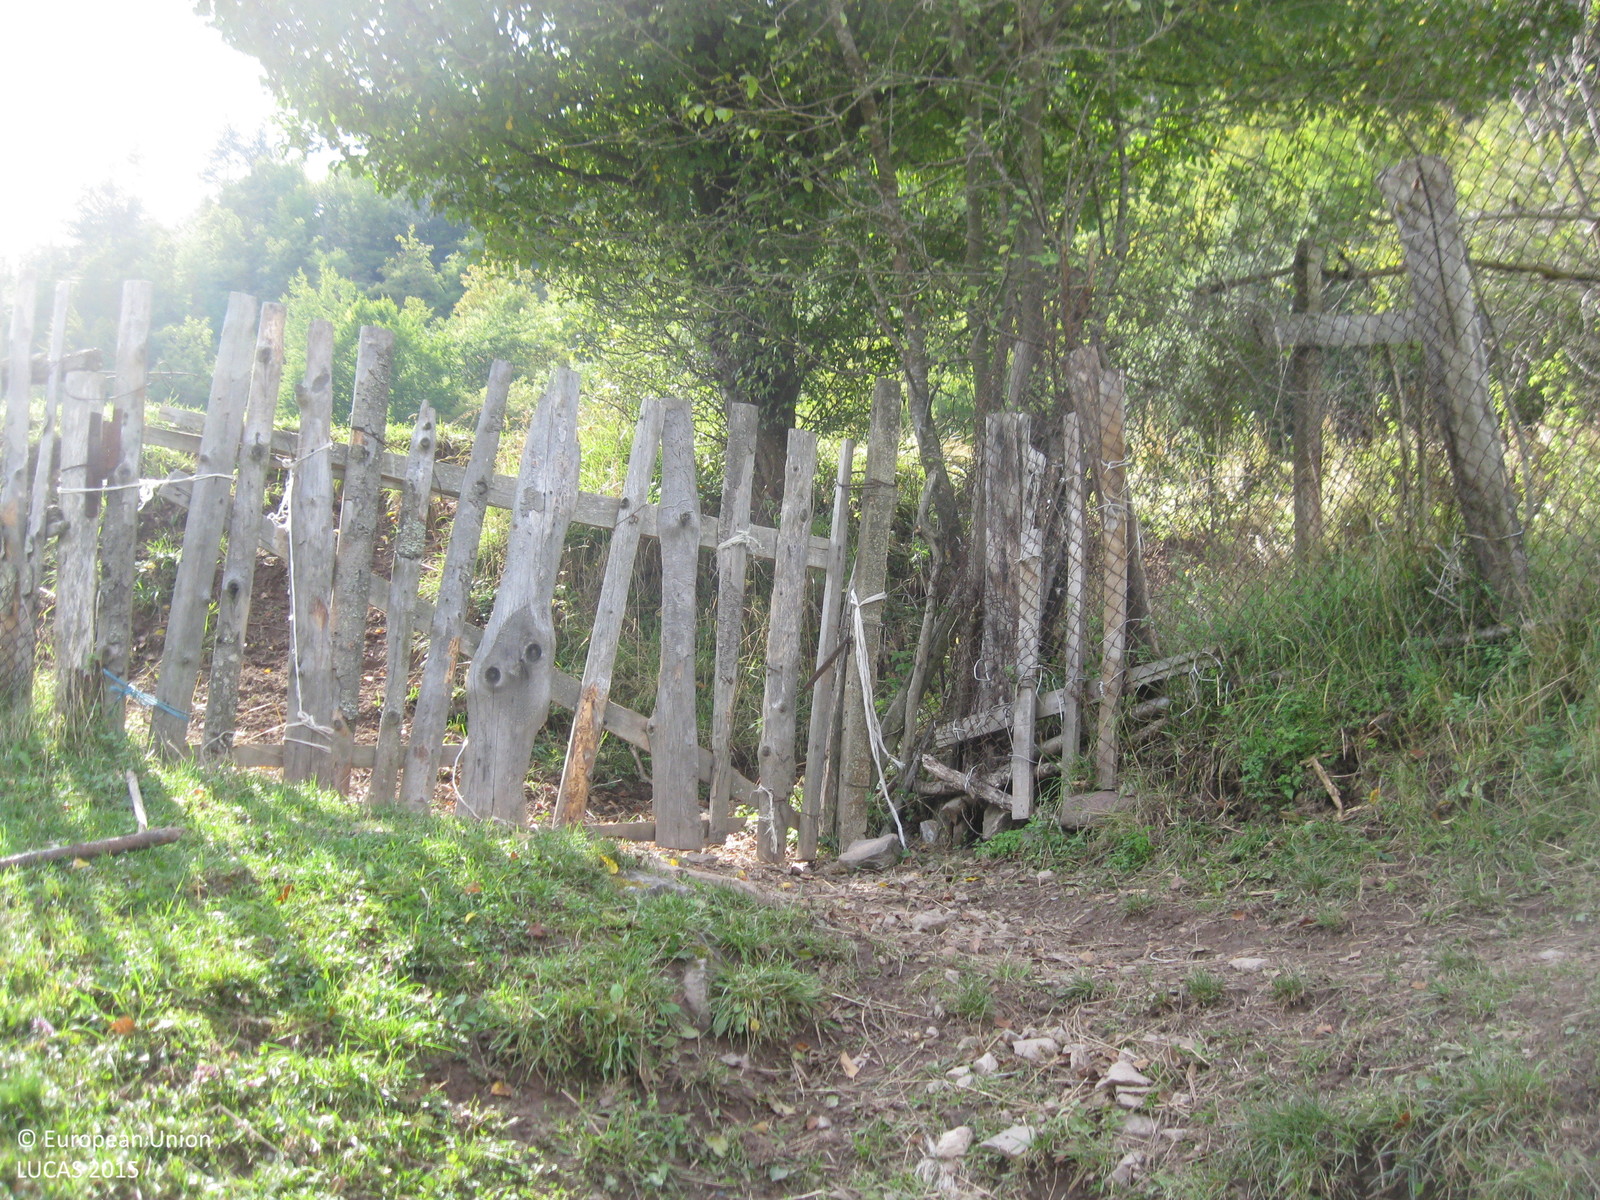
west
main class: Woodland
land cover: Pine dominated mixed woodland
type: mountainous beech forest
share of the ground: > 75 %
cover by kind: coniferous forest trees 50 %, broadleaved forest trees 45 %, shrubs 5 %
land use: Forestry
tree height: > 5 m
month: October
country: BG
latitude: 41.8207
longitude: 24.8943
